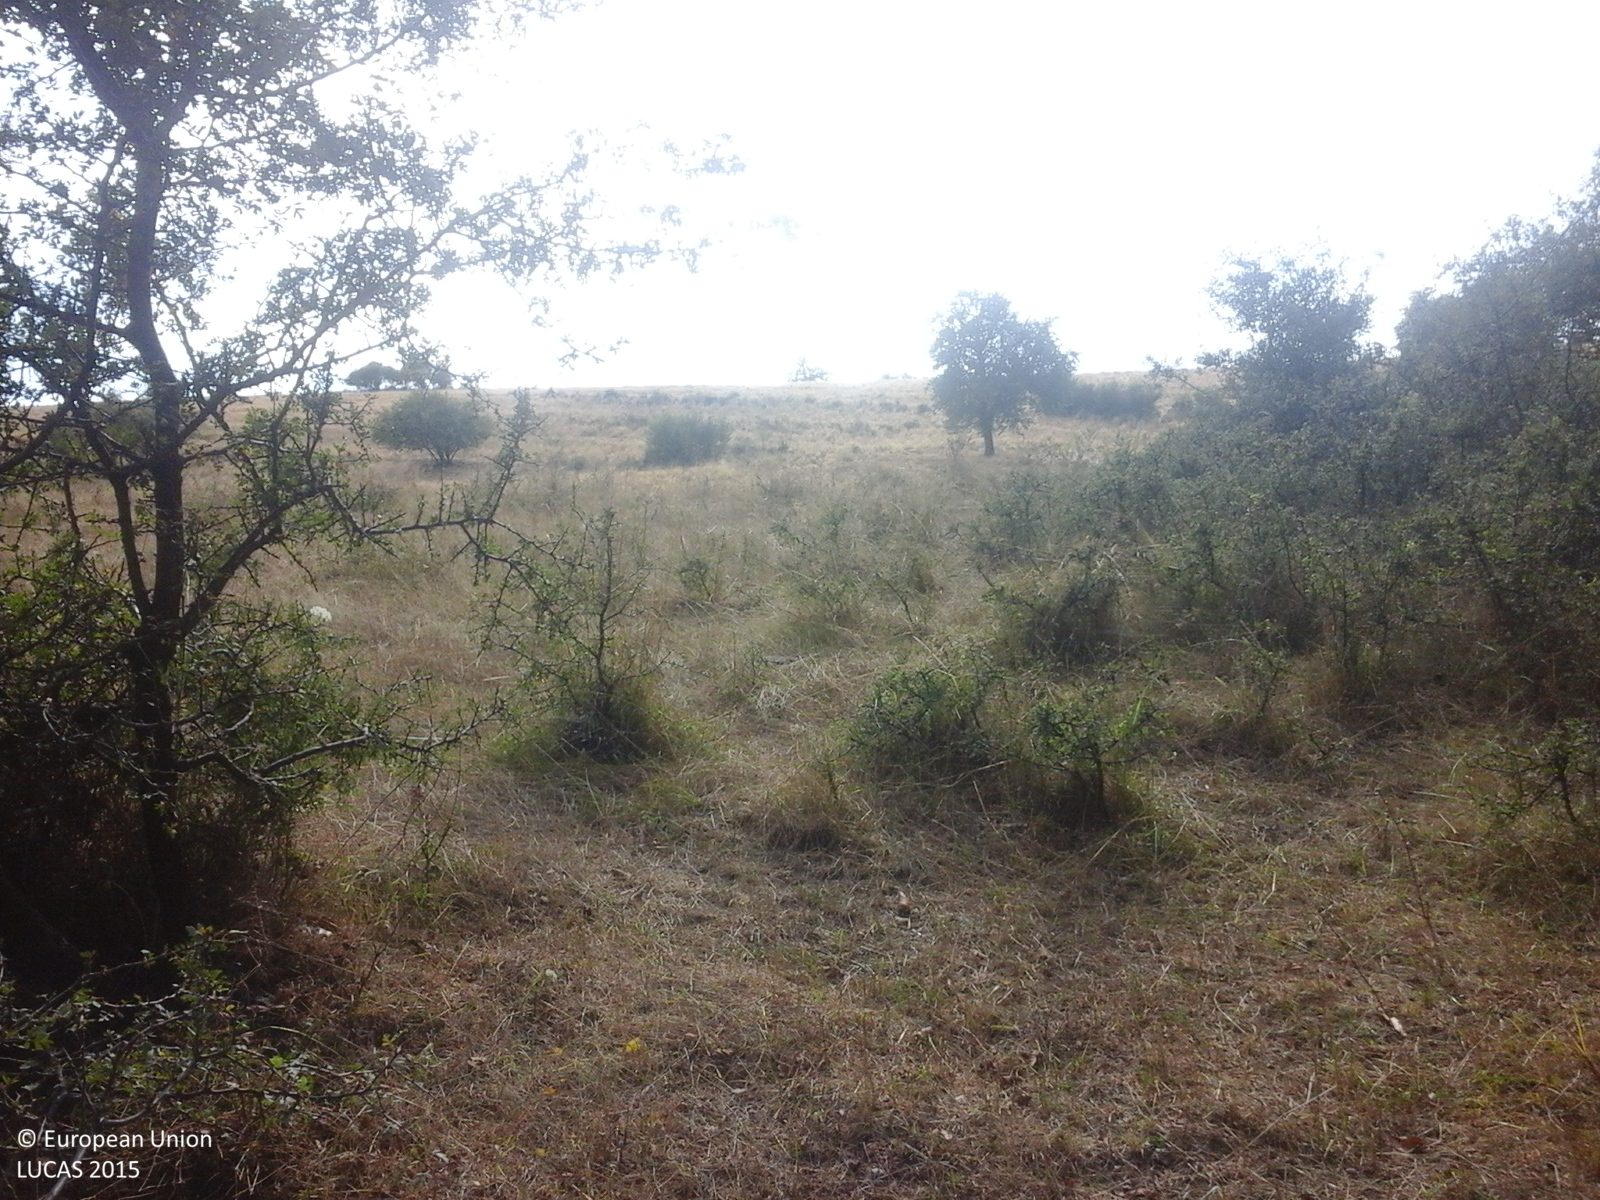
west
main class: Woodland
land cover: Broadleaved woodland
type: acidophilous oak and oak-birch forest
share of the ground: > 75 %
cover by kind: broadleaved forest trees 100 %
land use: Forestry
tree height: > 5 m
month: August
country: RO
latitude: 44.9077
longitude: 22.6199
